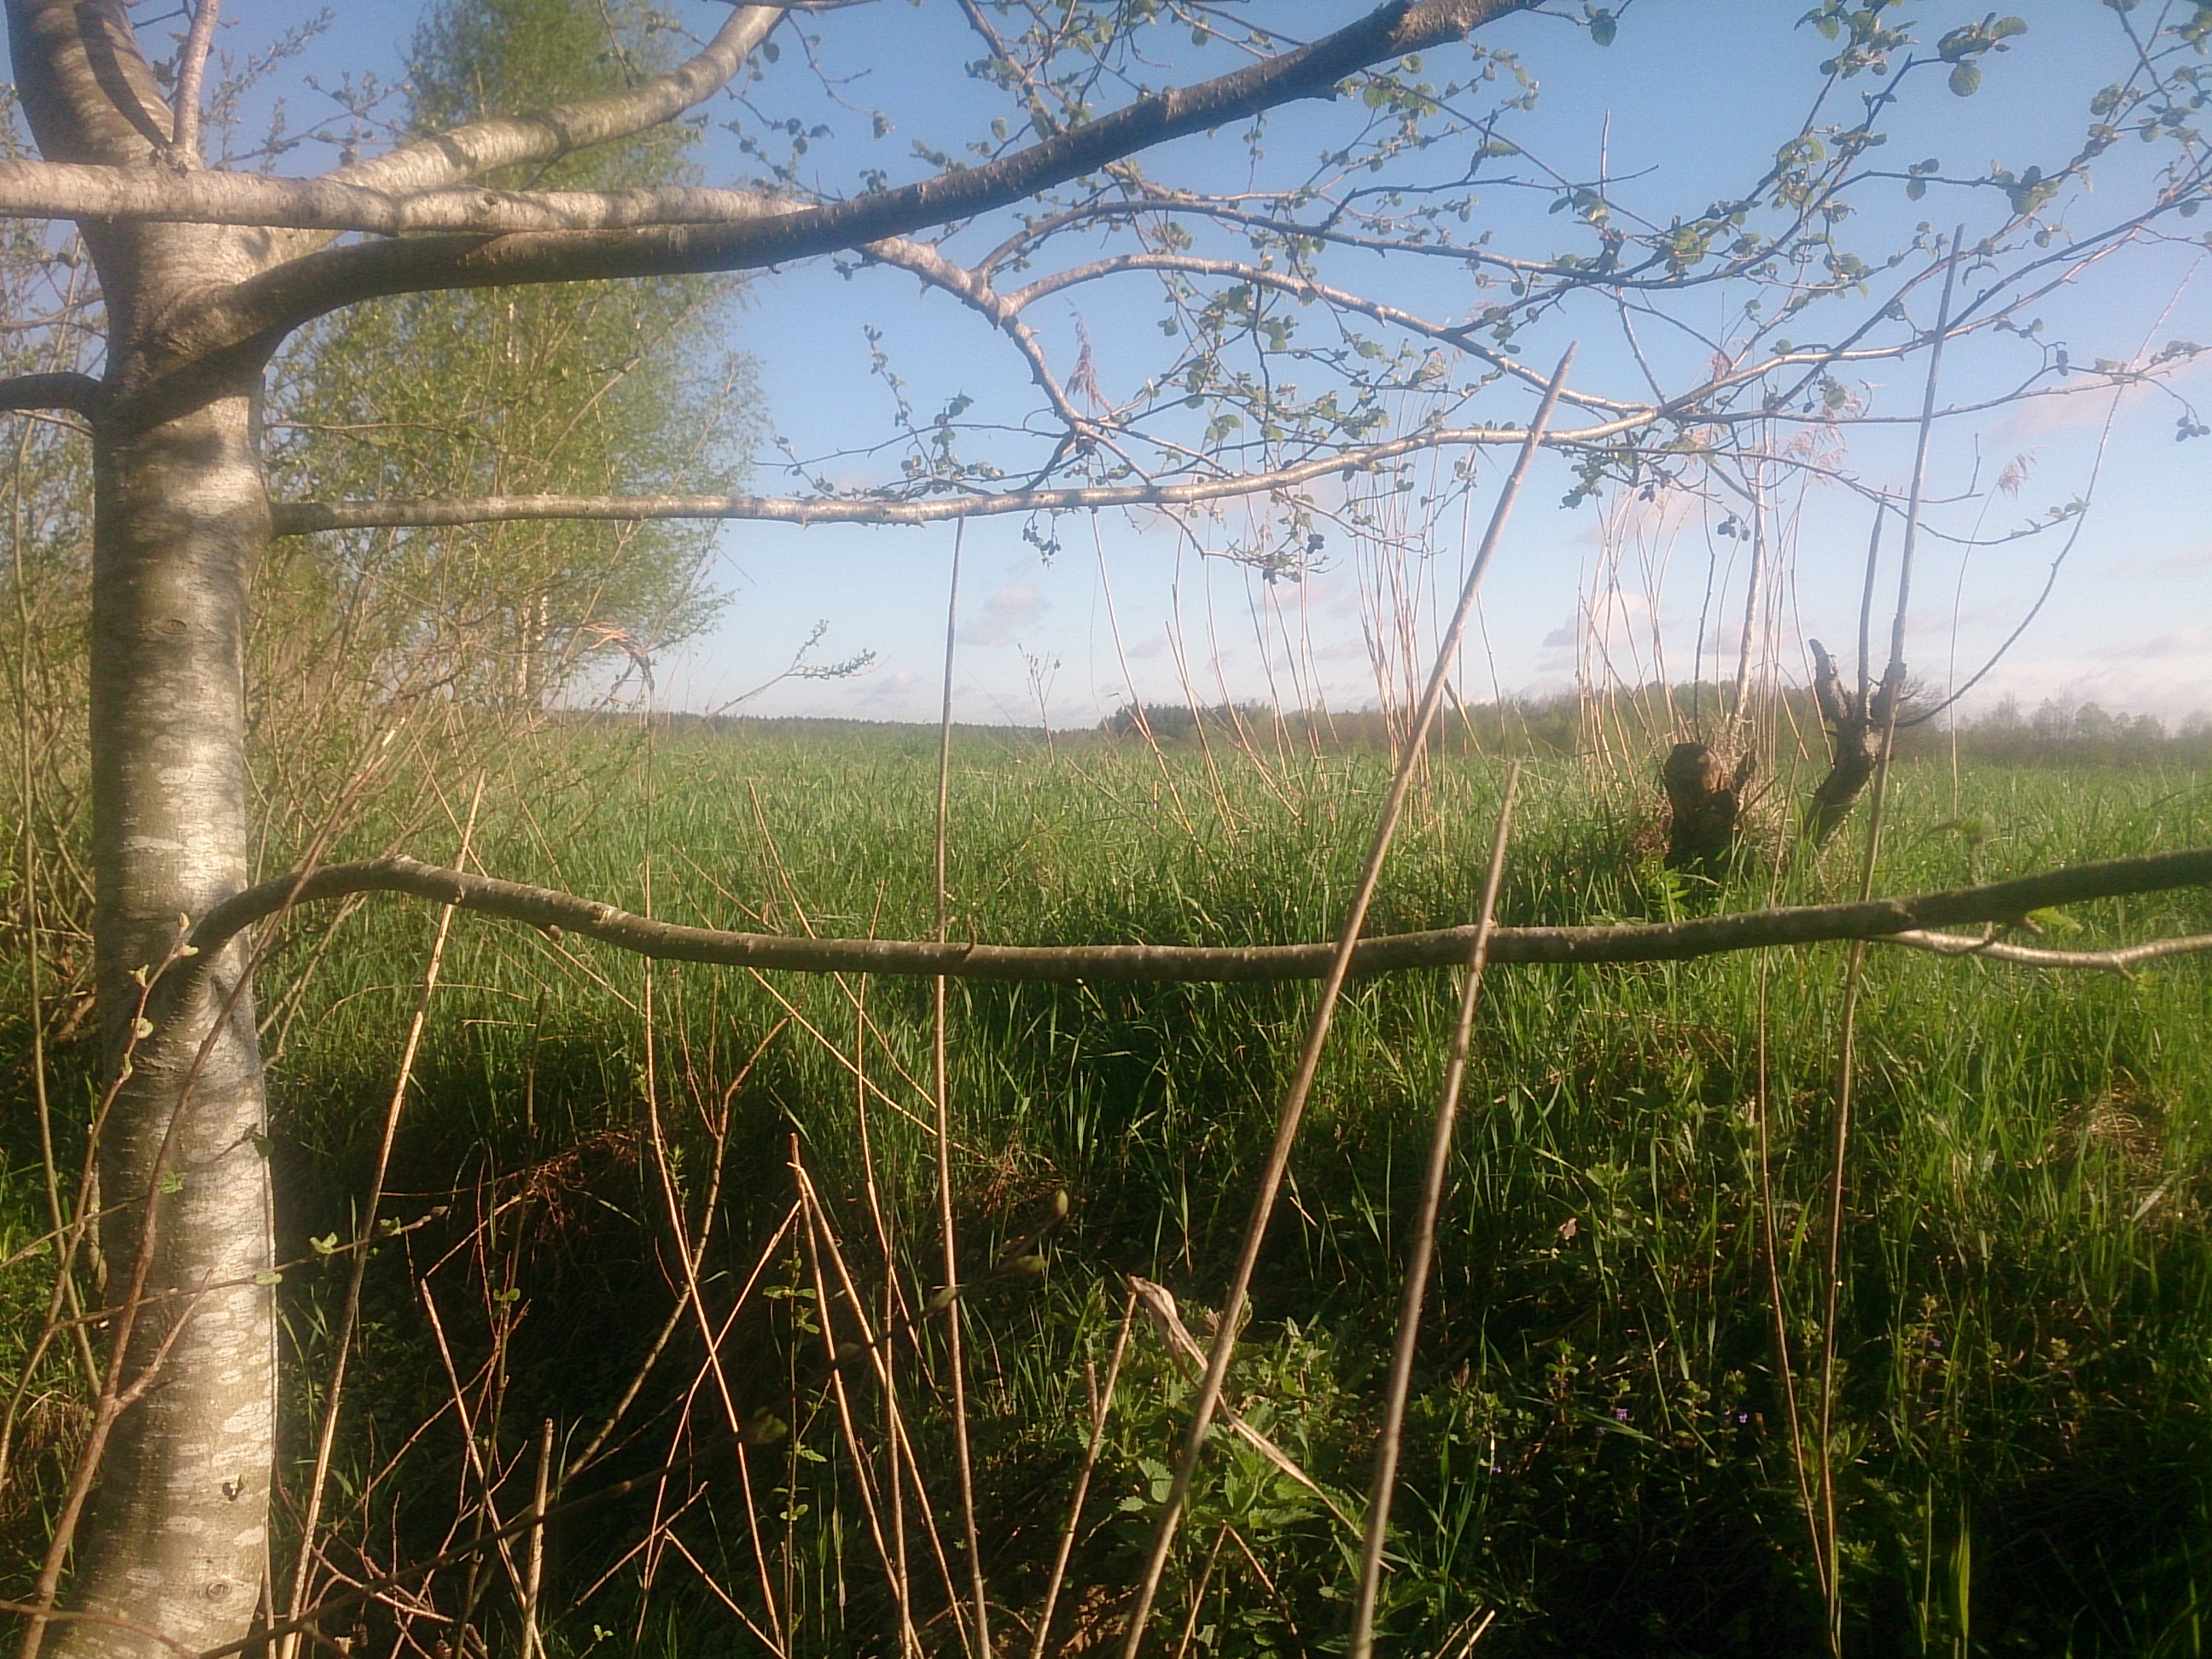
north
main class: Woodland
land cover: Broadleaved woodland
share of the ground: > 75 %
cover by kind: broadleaved forest trees 100 %
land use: Semi-natural and natural areas not in use
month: May
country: LV
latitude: 56.7602
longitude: 24.2383
